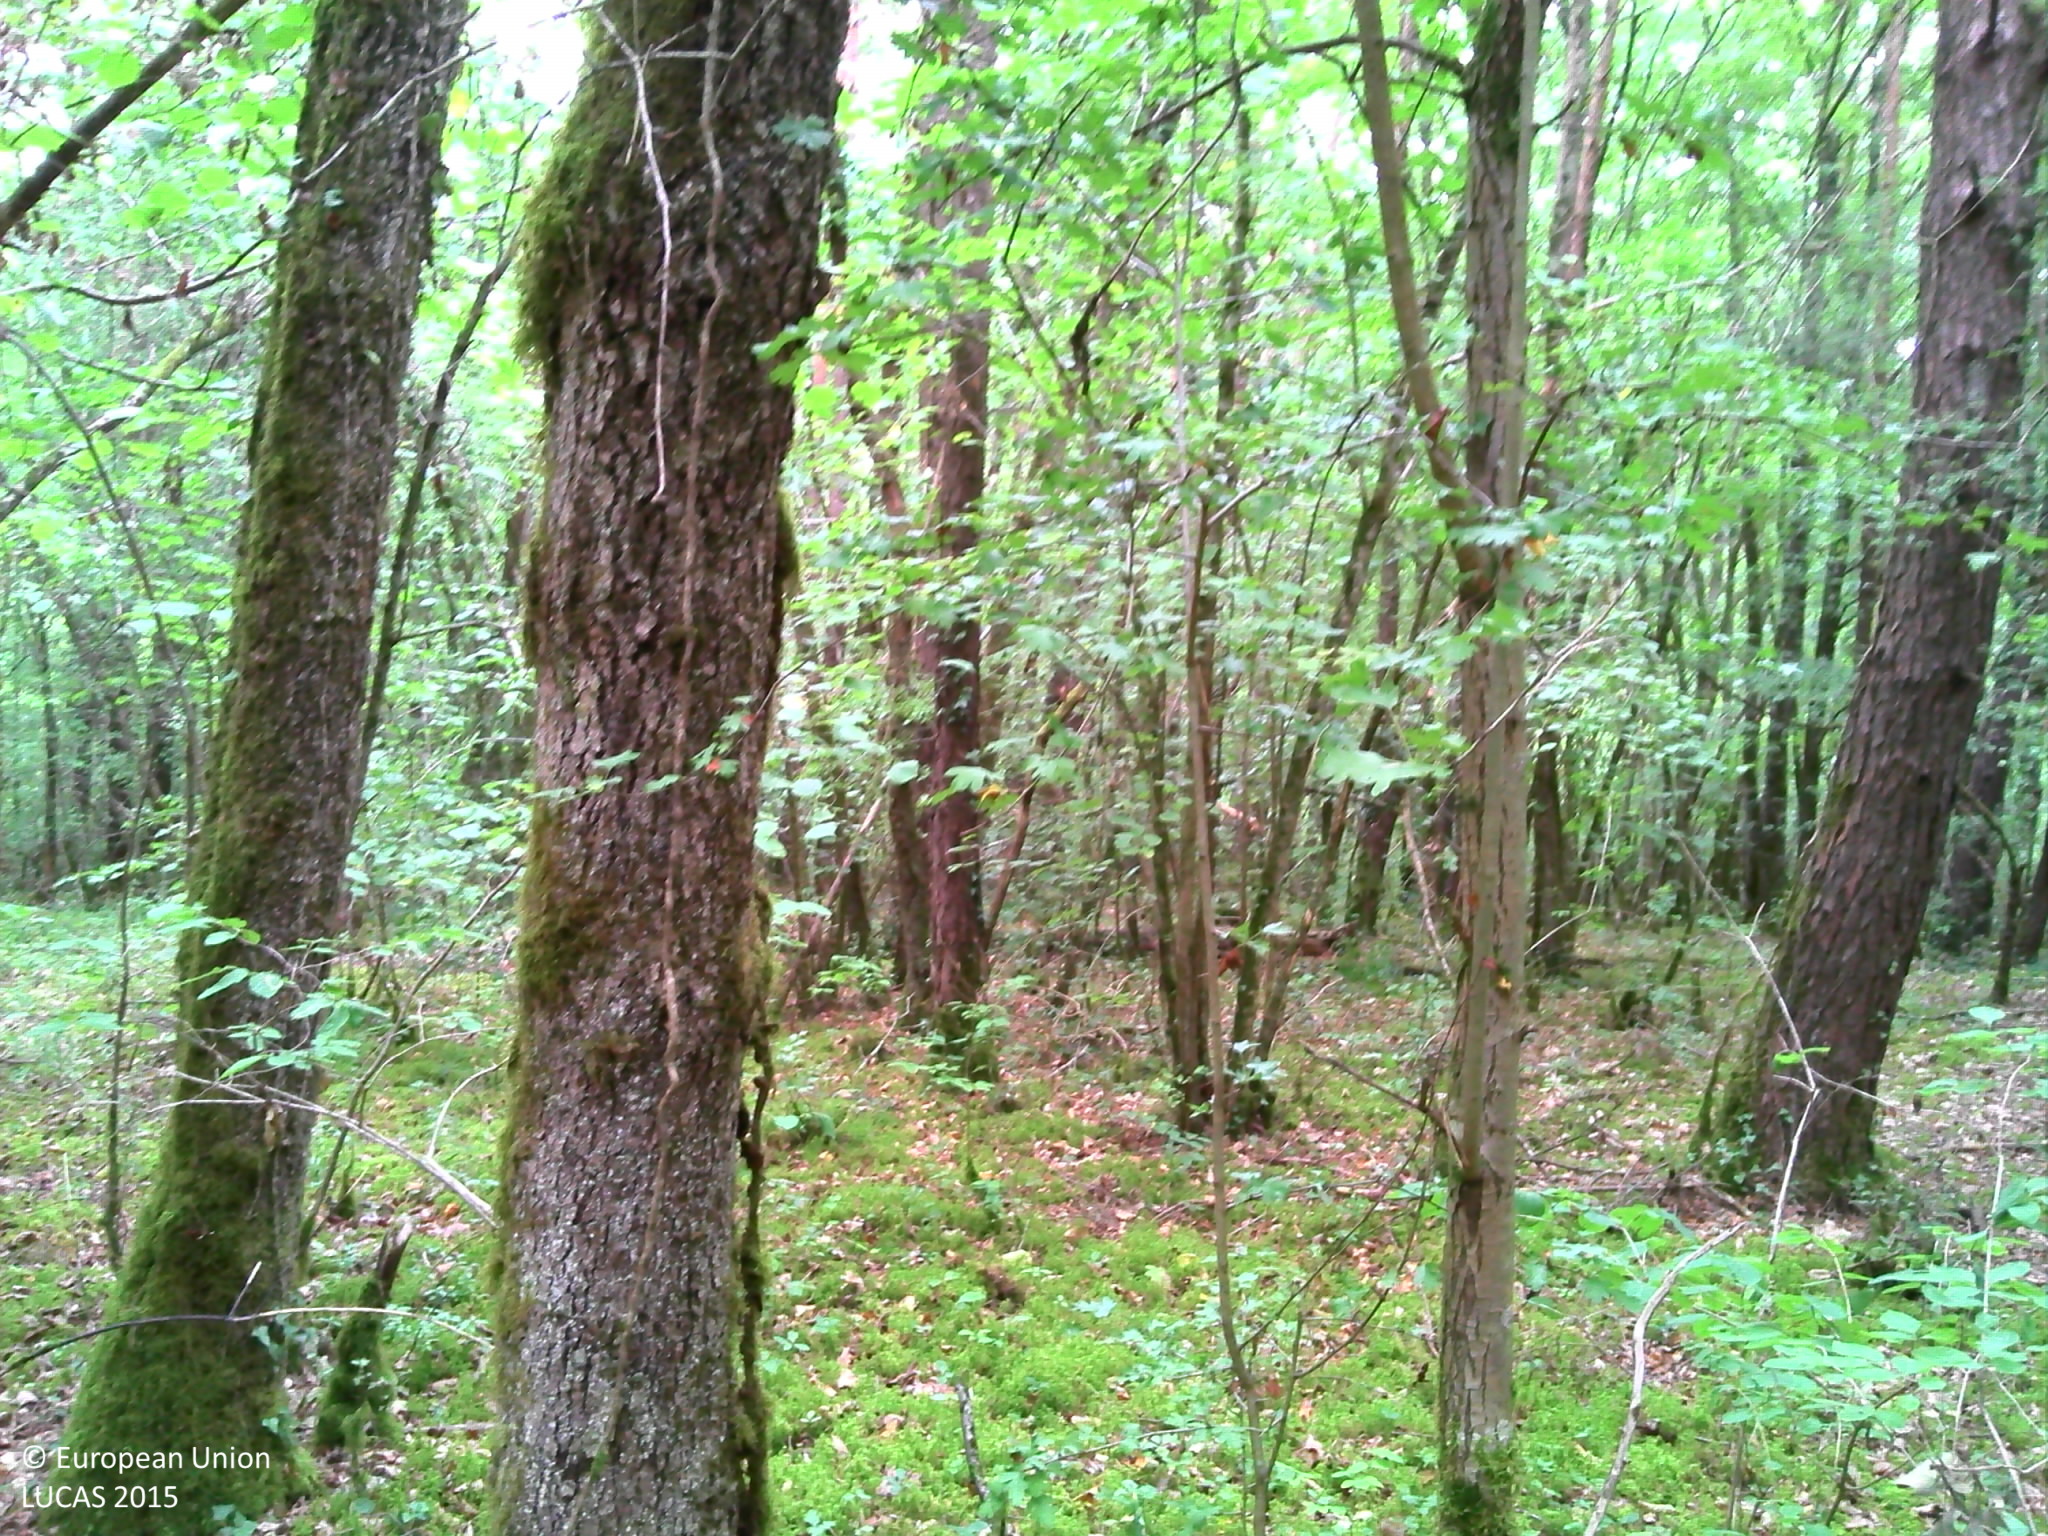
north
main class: Woodland
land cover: Pine dominated mixed woodland
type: mesophytic deciduous forest
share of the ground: > 75 %
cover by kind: coniferous forest trees 60 %, broadleaved forest trees 30 %, herbaceous plants 5 %, lichens and mosses 5 %
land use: Forestry
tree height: > 5 m
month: August
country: FR
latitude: 47.9502
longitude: 4.3070
